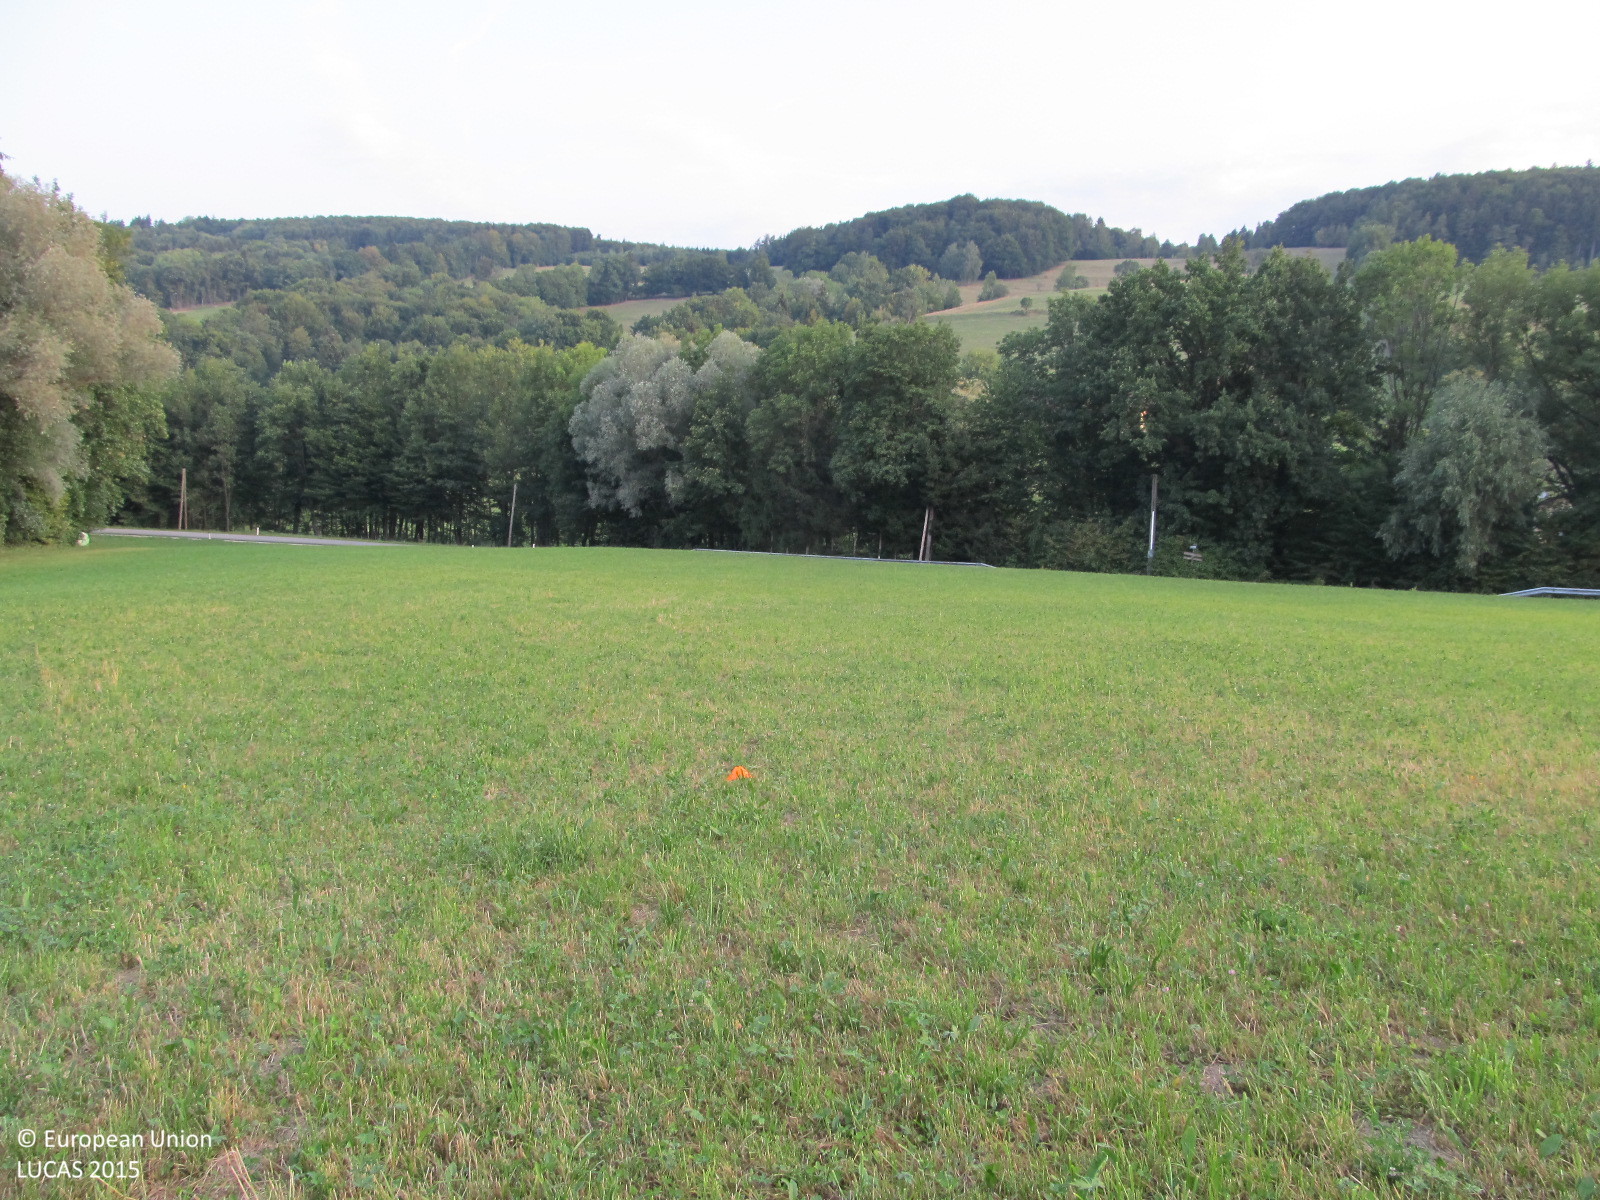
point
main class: Grassland
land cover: Grassland without tree/shrub cover
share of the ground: > 75 %
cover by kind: herbaceous plants 100 %
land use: Agriculture (excluding fallow land and kitchen gardens)
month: August
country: AT
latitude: 48.0573
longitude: 15.3552
